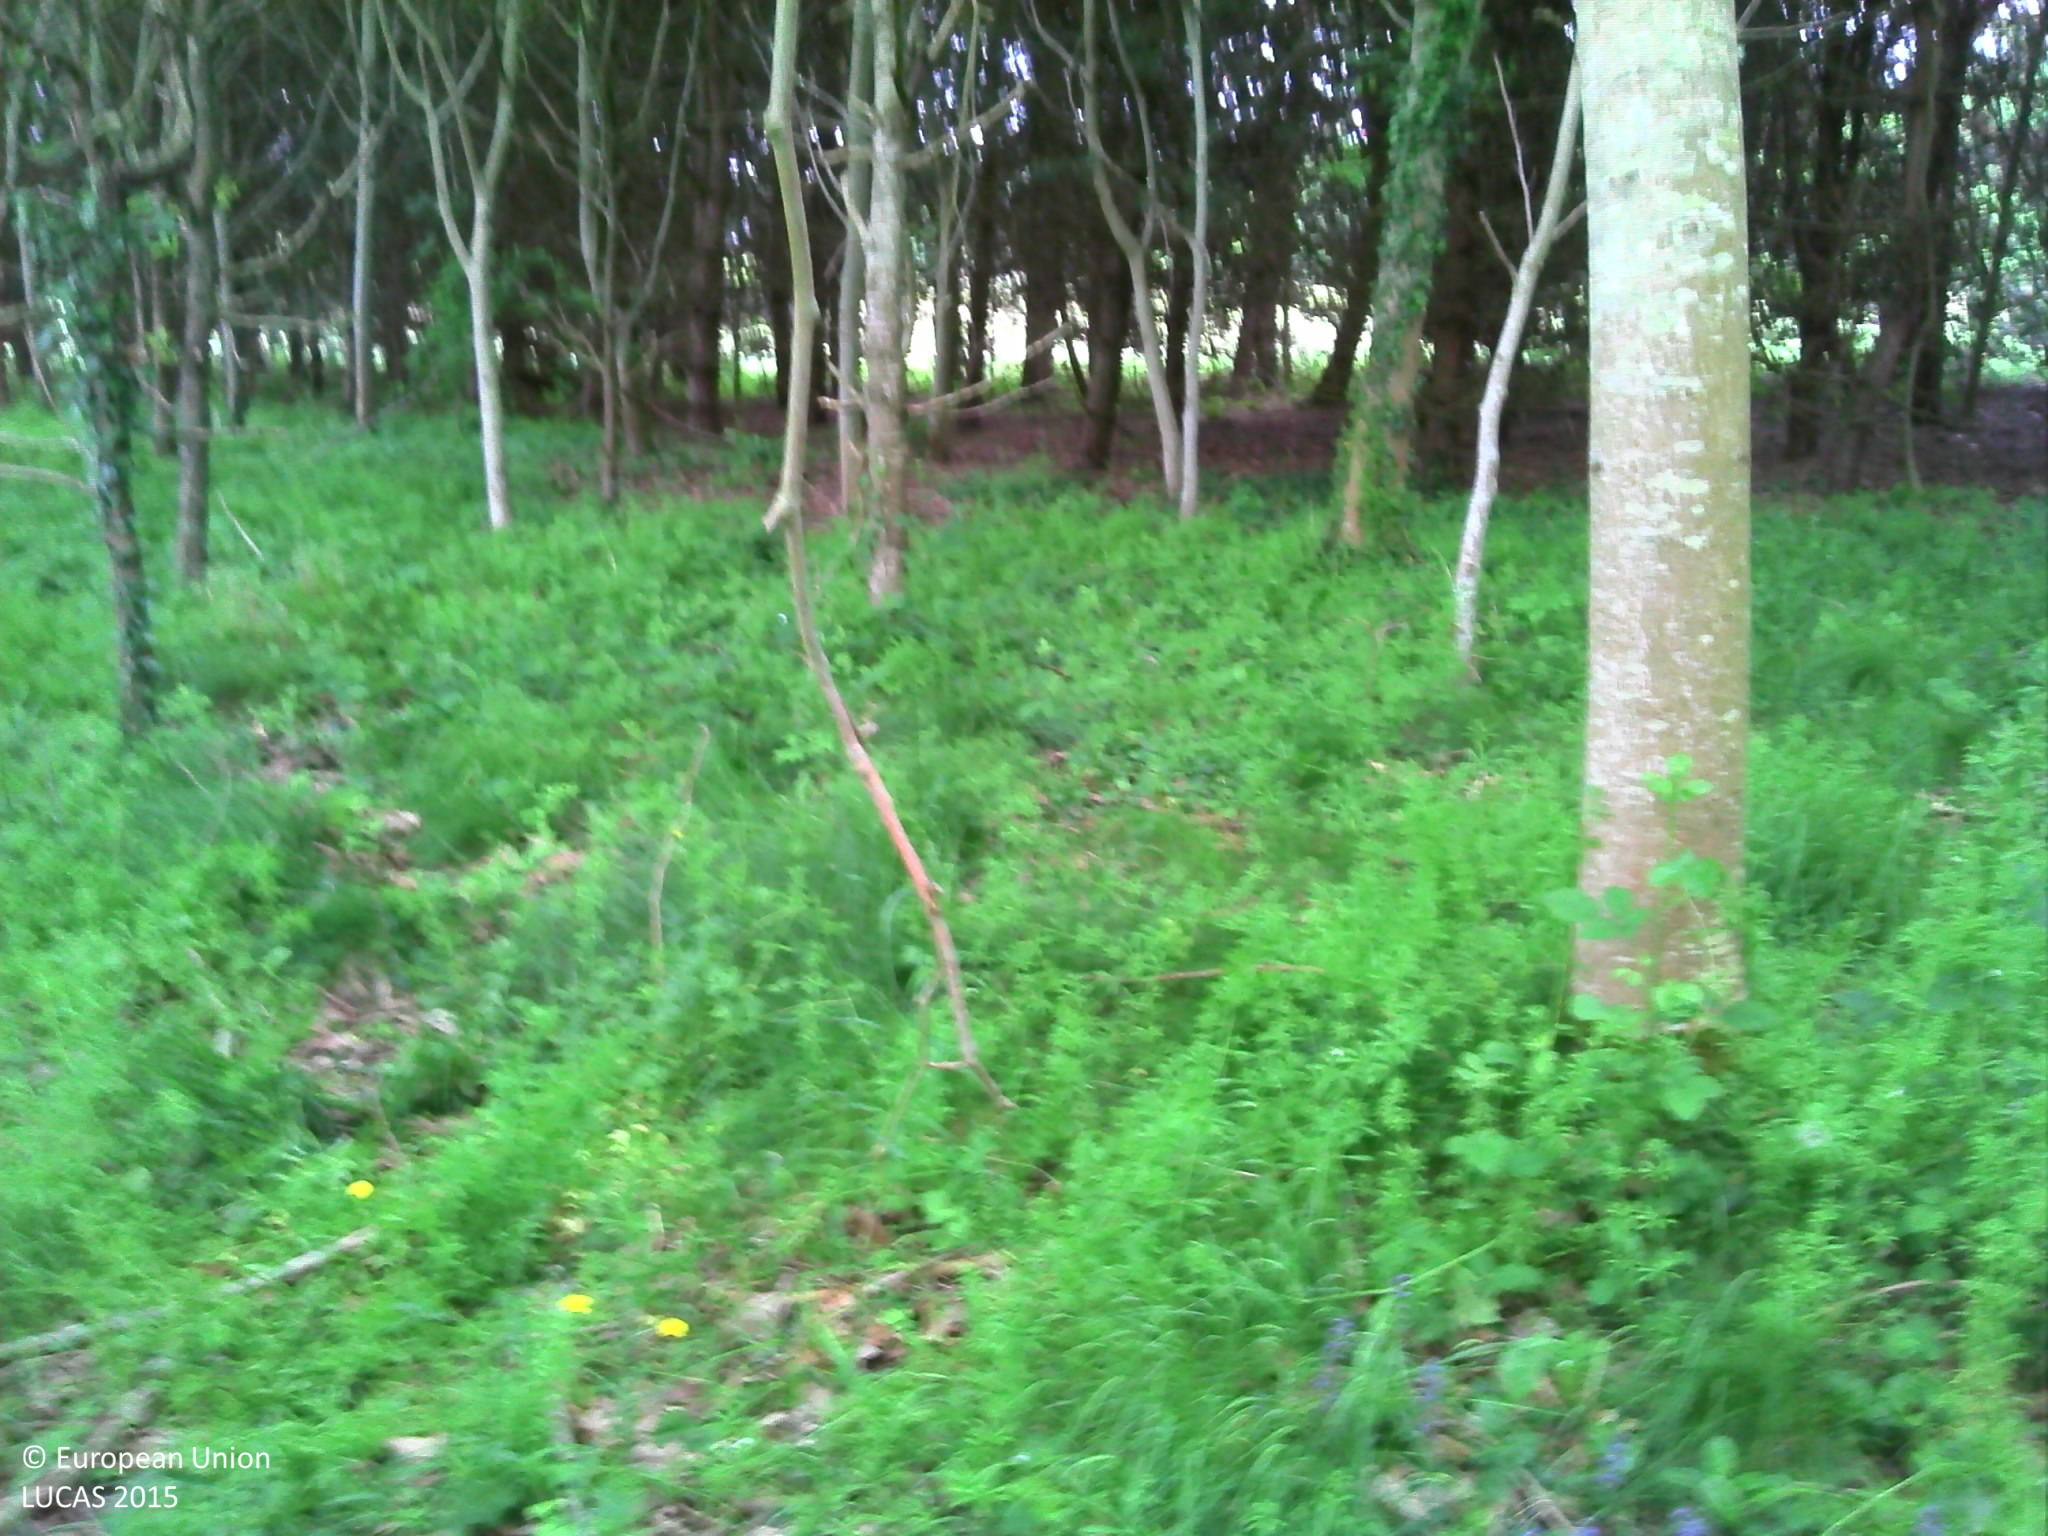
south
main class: Woodland
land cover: Broadleaved woodland
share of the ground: > 75 %
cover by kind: broadleaved forest trees 85 %, shrubs 10 %, herbaceous plants 5 %
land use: Forestry
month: May
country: FR
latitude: 49.3107
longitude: 0.0242
